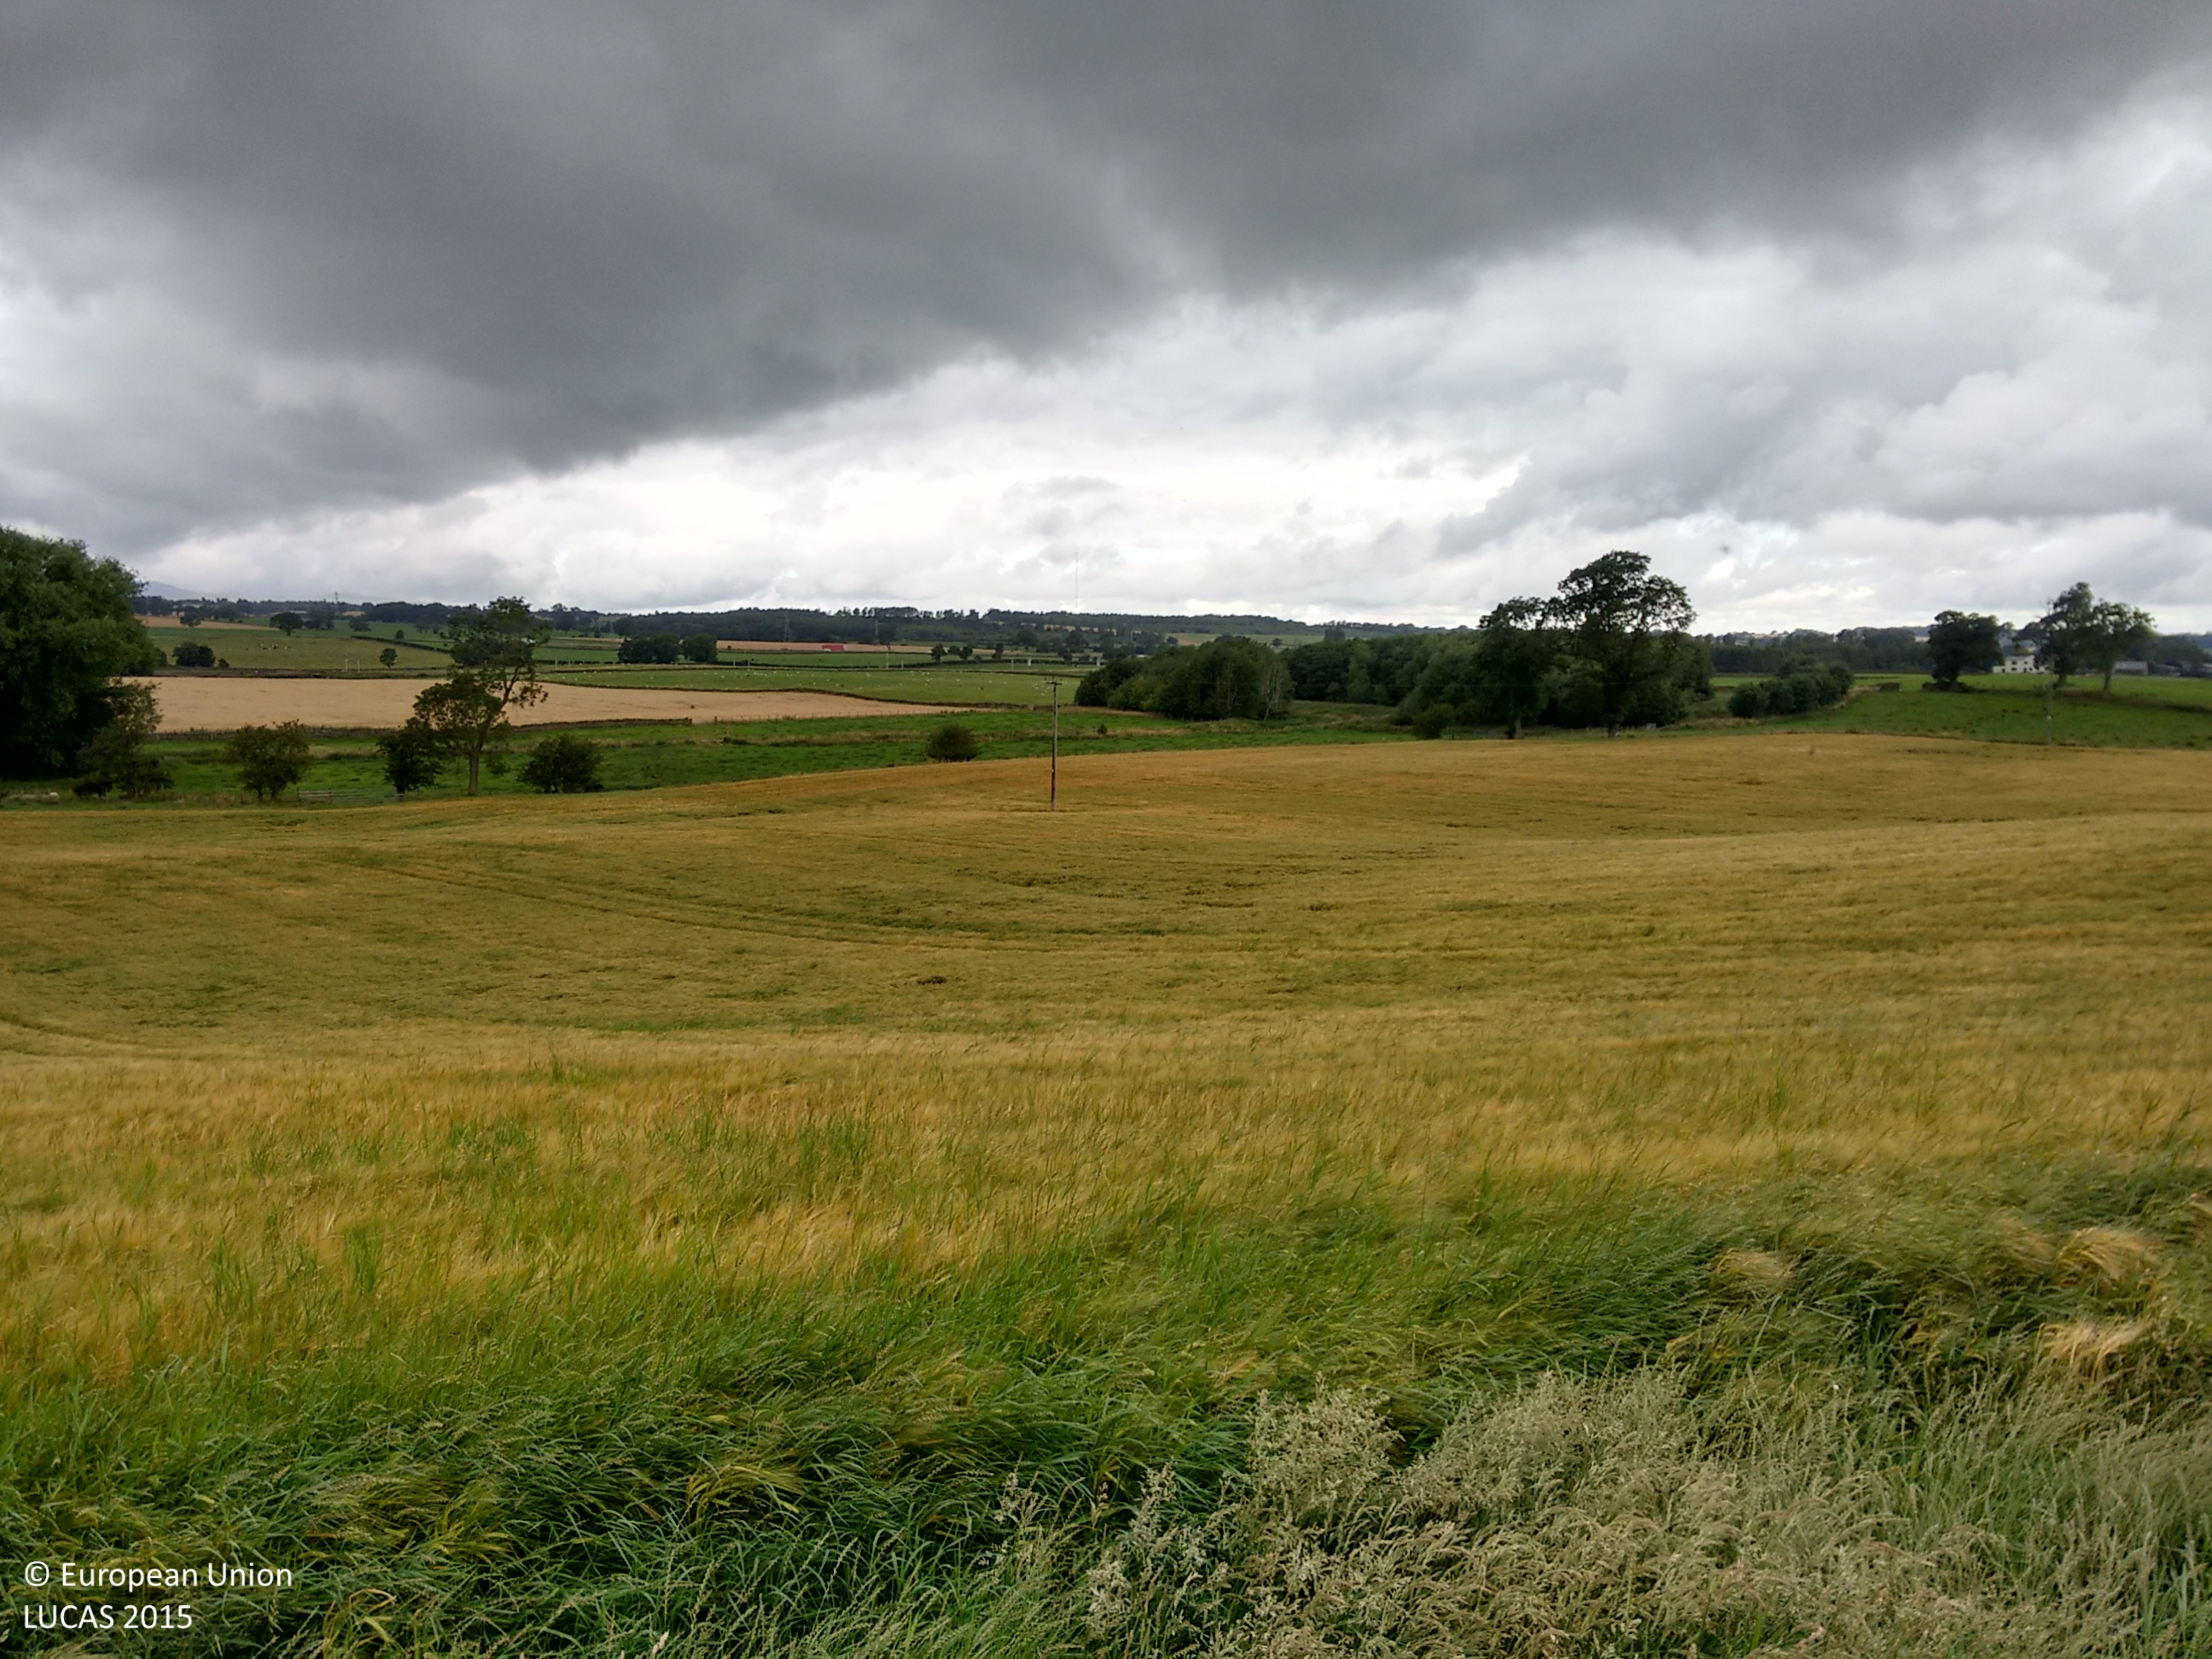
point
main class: Cropland
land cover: Barley
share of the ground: > 75 %
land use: Agriculture (excluding fallow land and kitchen gardens)
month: August
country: GB
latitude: 54.7071
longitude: -2.7790
